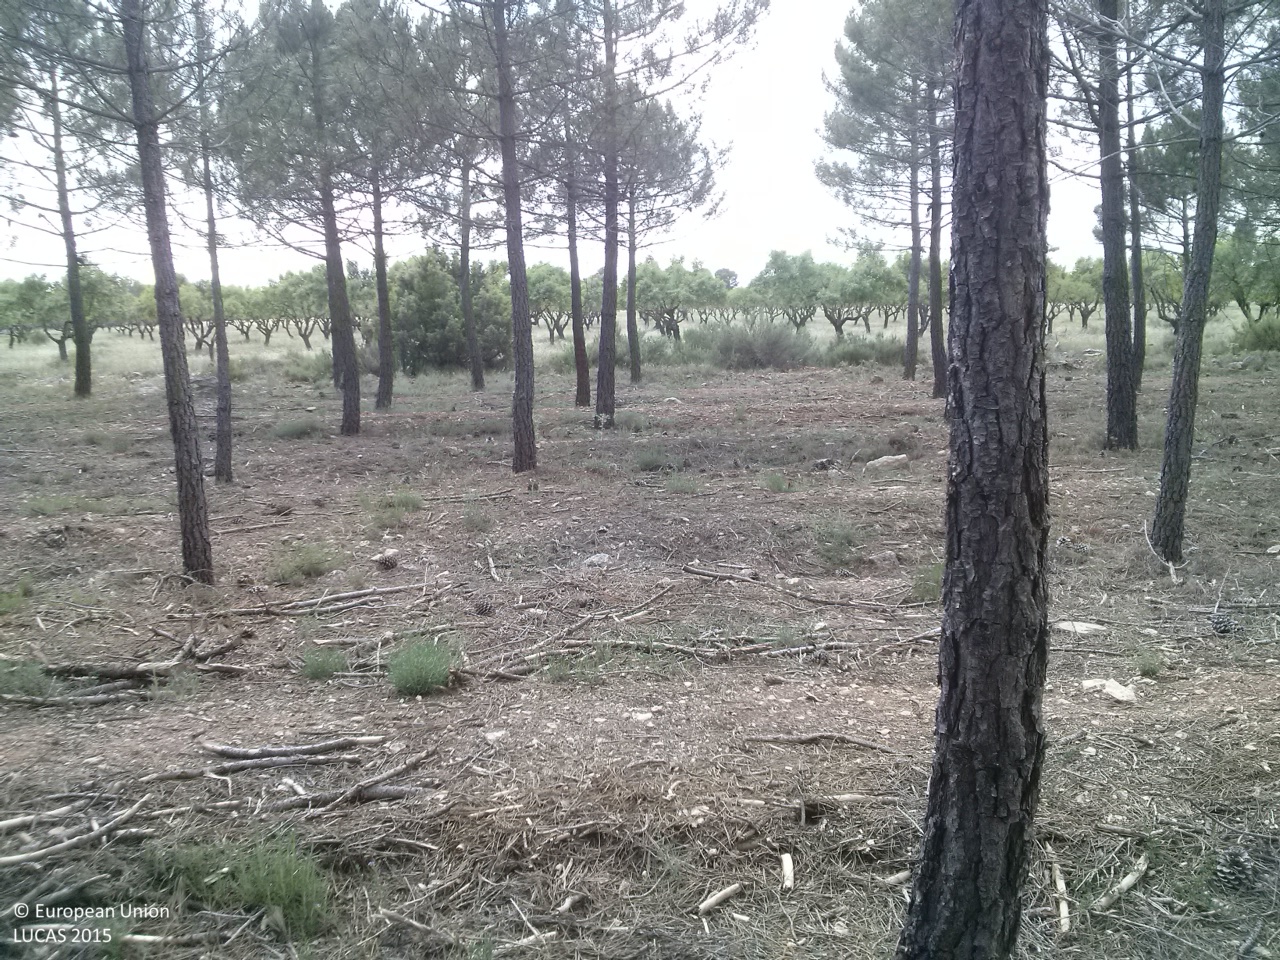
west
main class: Woodland
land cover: Pine dominated coniferous woodland
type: coniferous forest of the mediterranean region
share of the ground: 25 - 50 %
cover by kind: coniferous forest trees 50 %, herbaceous plants 20 %, unconsolidated bare surface 20 %, shrubs 10 %
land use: Forestry
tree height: > 5 m
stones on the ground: 25 - 50 %
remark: Clear cut
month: June
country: ES
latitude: 39.6770
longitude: -1.6776
